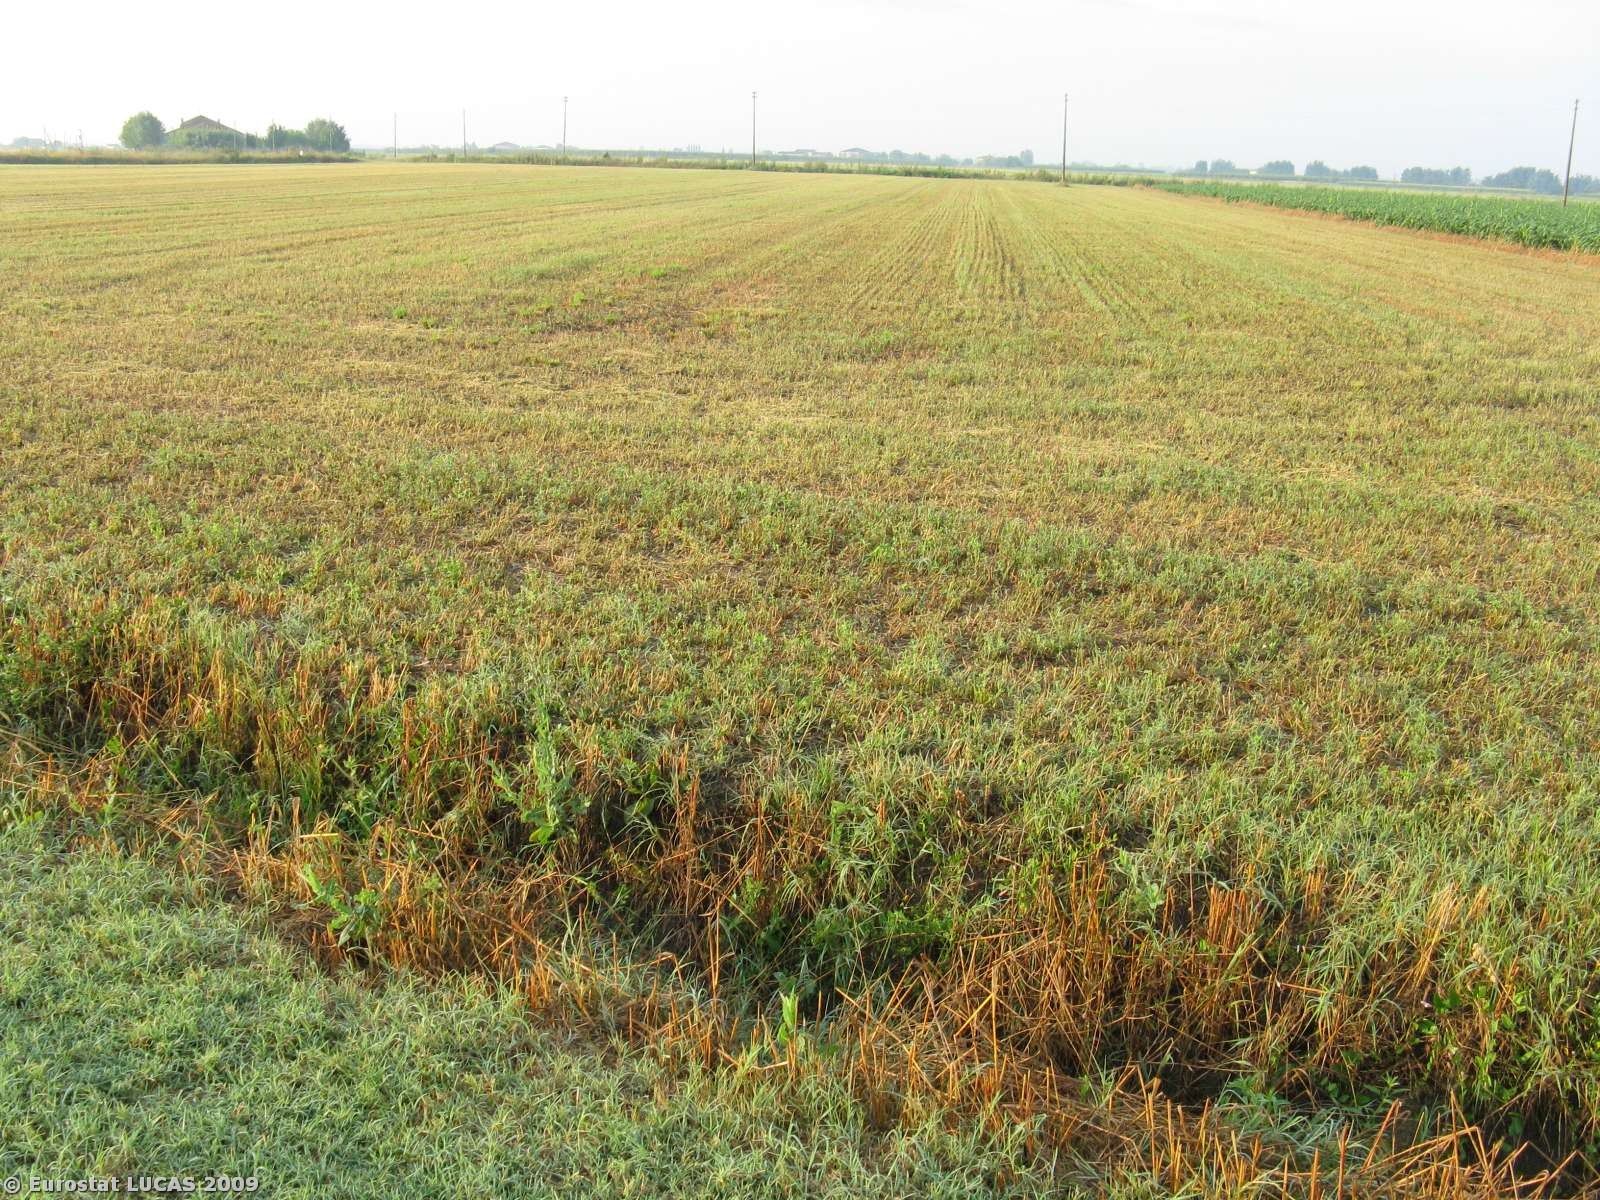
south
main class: Cropland
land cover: Other cereals
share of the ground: > 75 %
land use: Agriculture (excluding fallow land and kitchen gardens)
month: July
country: IT
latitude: 44.7695
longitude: 11.7024
